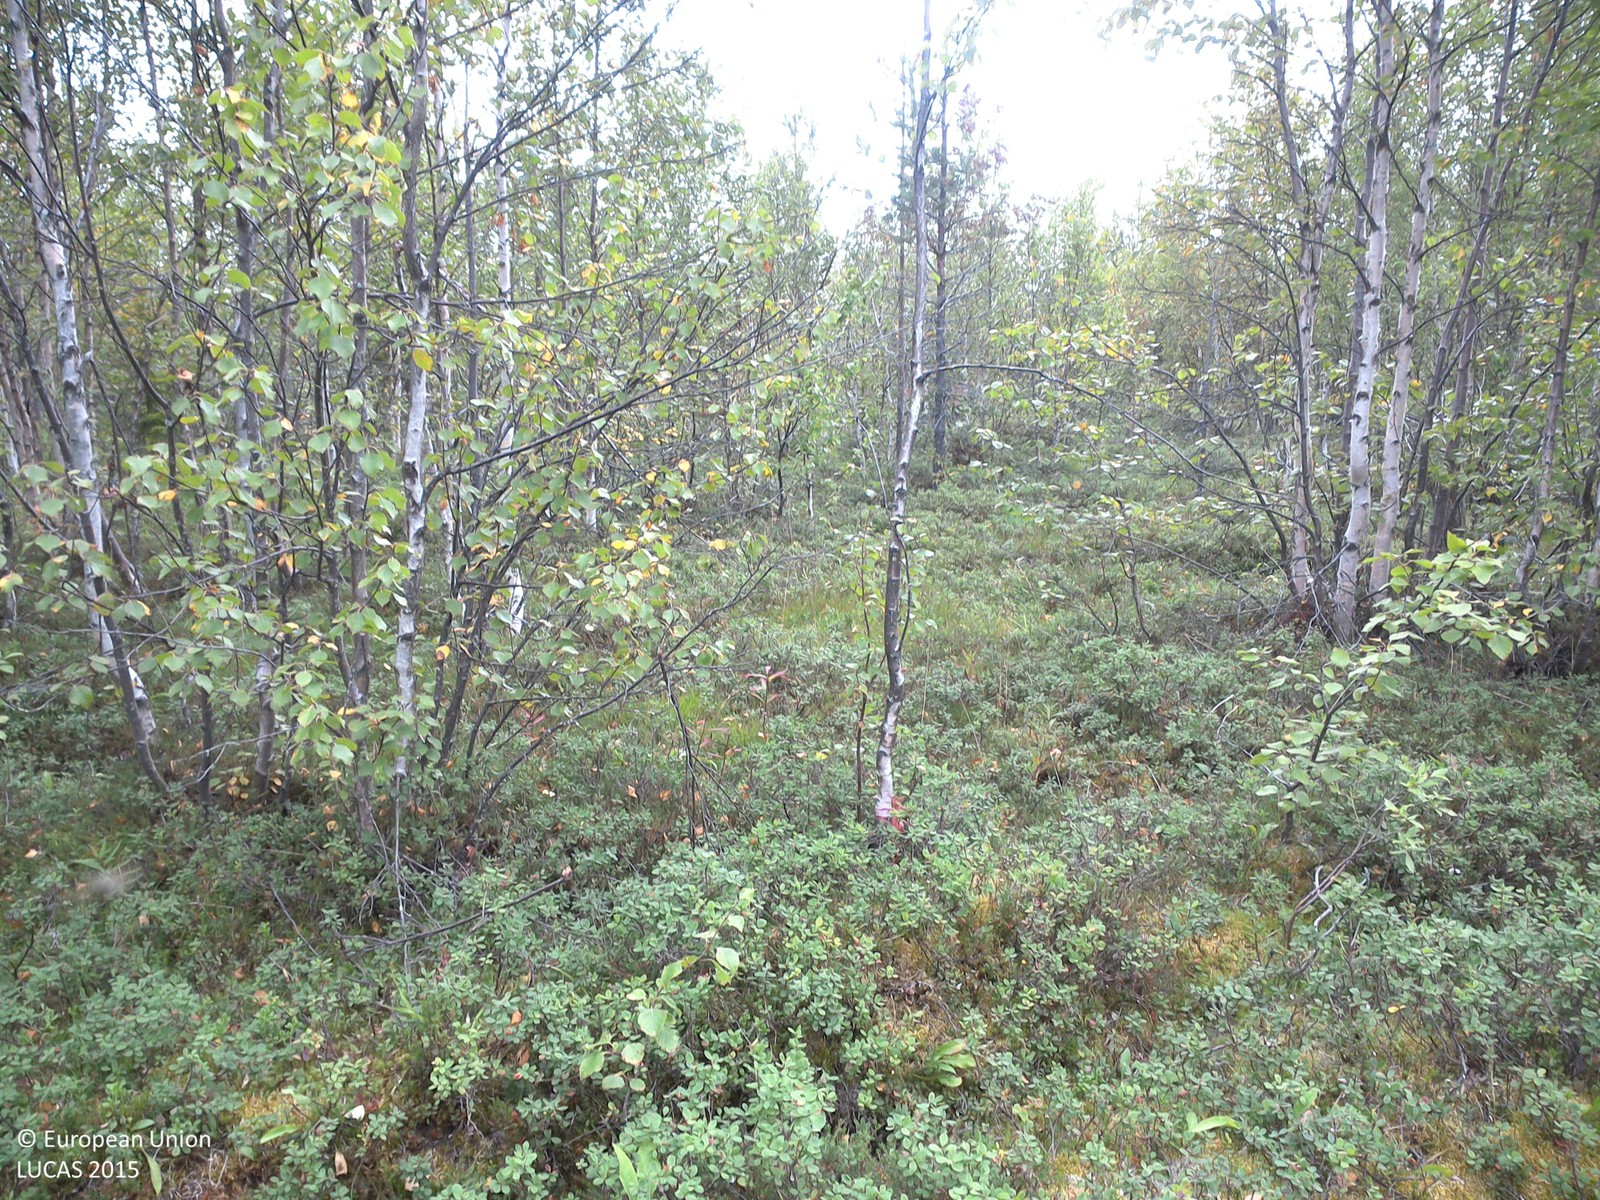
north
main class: Woodland
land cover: Other mixed woodland
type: boreal forest
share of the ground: 25 - 50 %
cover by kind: shrubs 65 %, broadleaved forest trees 20 %, coniferous forest trees 10 %, lichens and mosses 5 %
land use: Forestry
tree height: > 5 m
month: August
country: SE
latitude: 67.3410
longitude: 22.1689
